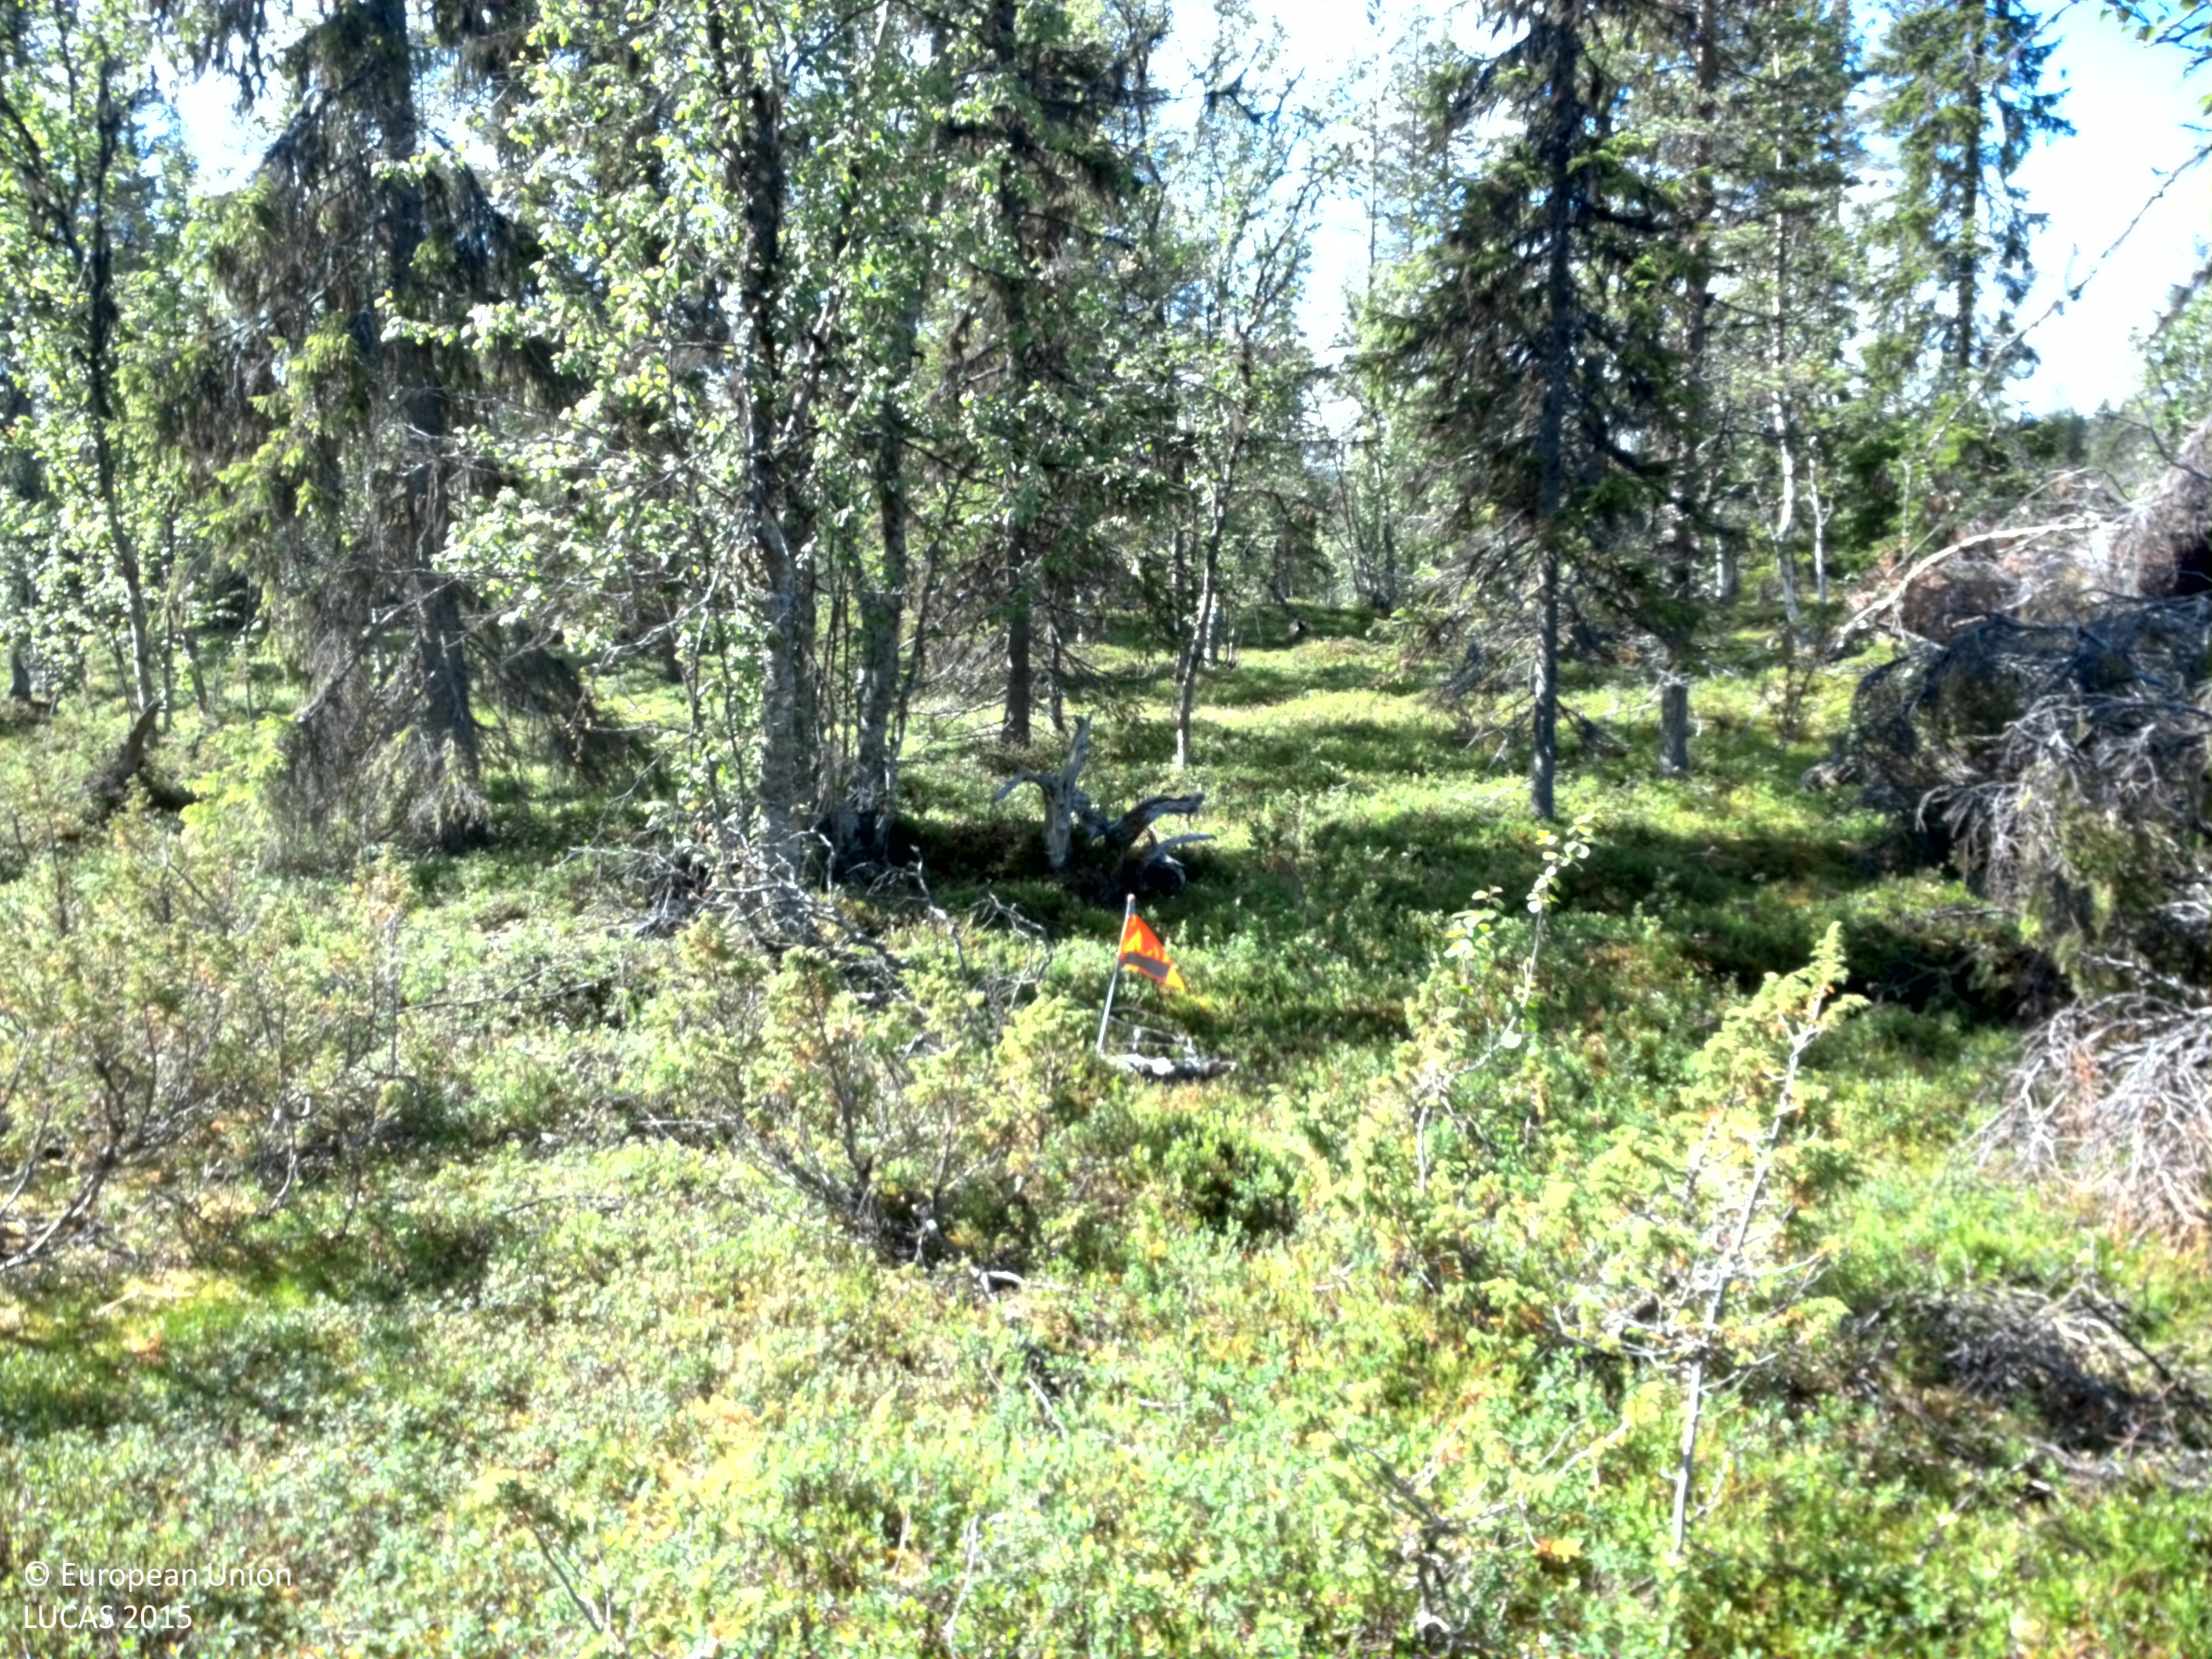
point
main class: Woodland
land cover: Spruce dominated mixed woodland
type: boreal forest
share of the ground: 10 - 25 %
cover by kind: shrubs 70 %, lichens and mosses 15 %, coniferous forest trees 10 %, broadleaved forest trees 5 %
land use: Forestry
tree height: > 5 m
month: August
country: SE
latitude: 64.8949
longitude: 16.1554
